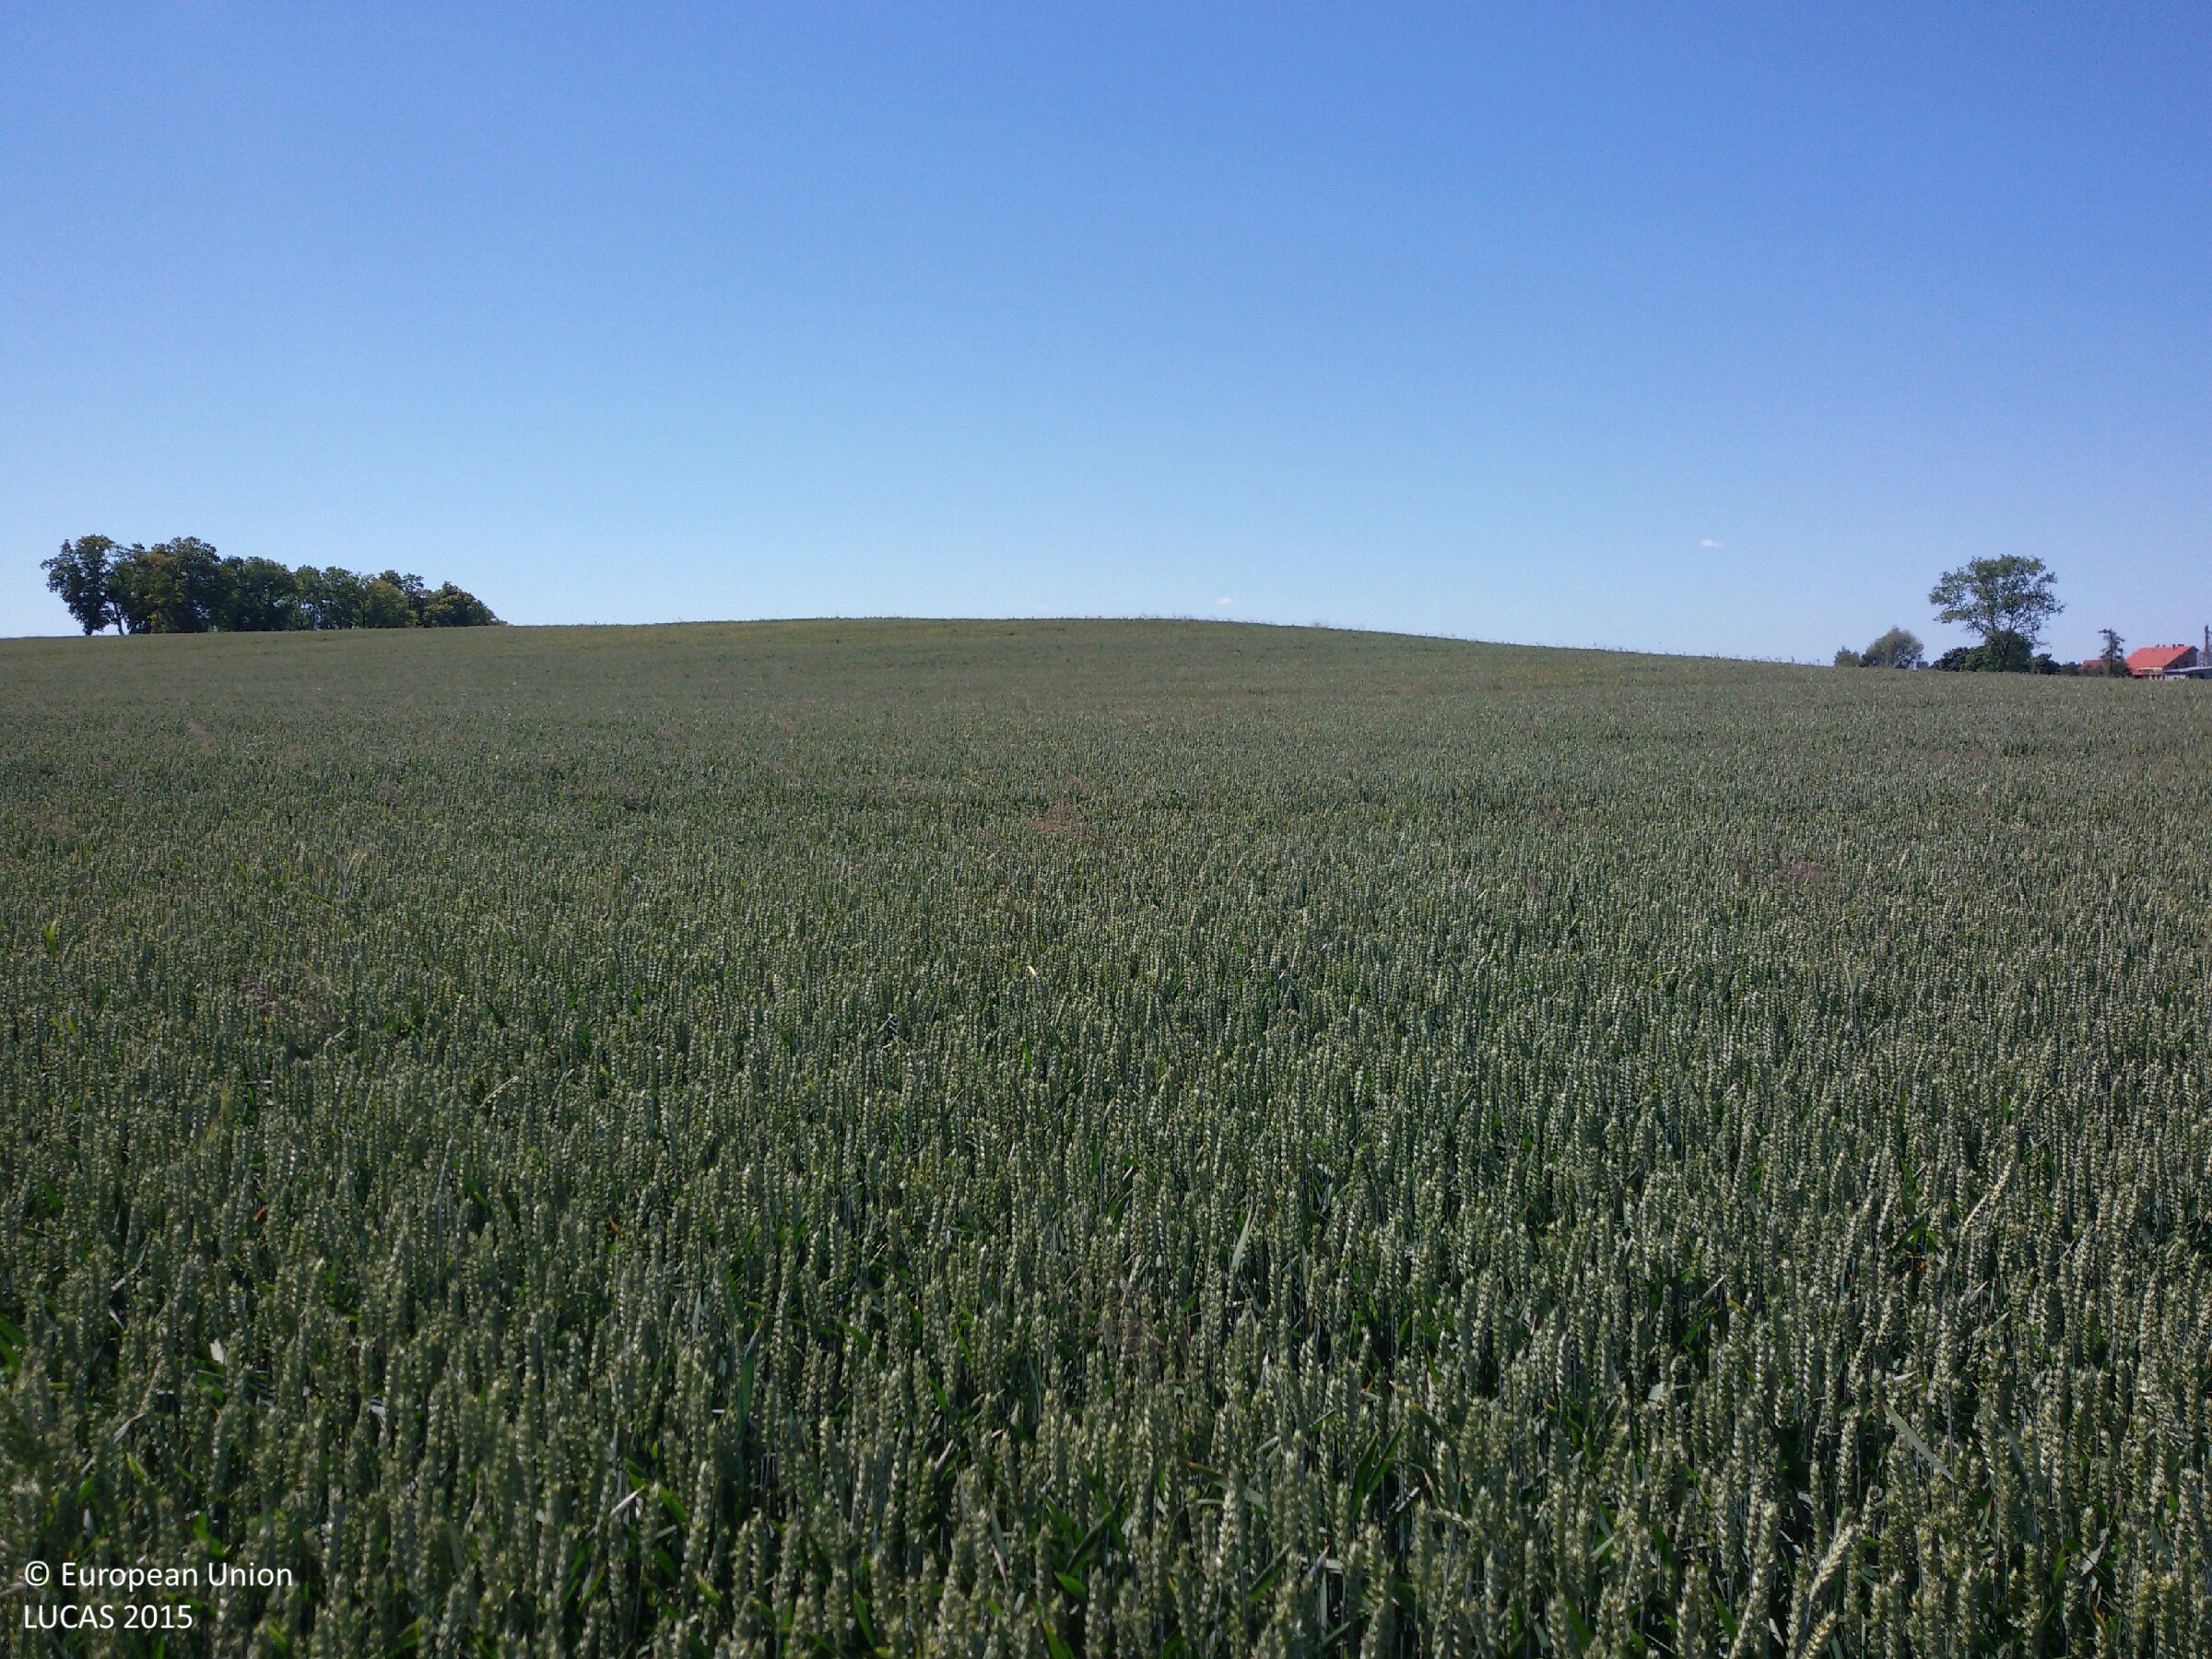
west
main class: Cropland
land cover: Common wheat
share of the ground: > 75 %
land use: Agriculture (excluding fallow land and kitchen gardens)
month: July
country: PL
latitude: 53.7857
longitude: 19.2981
